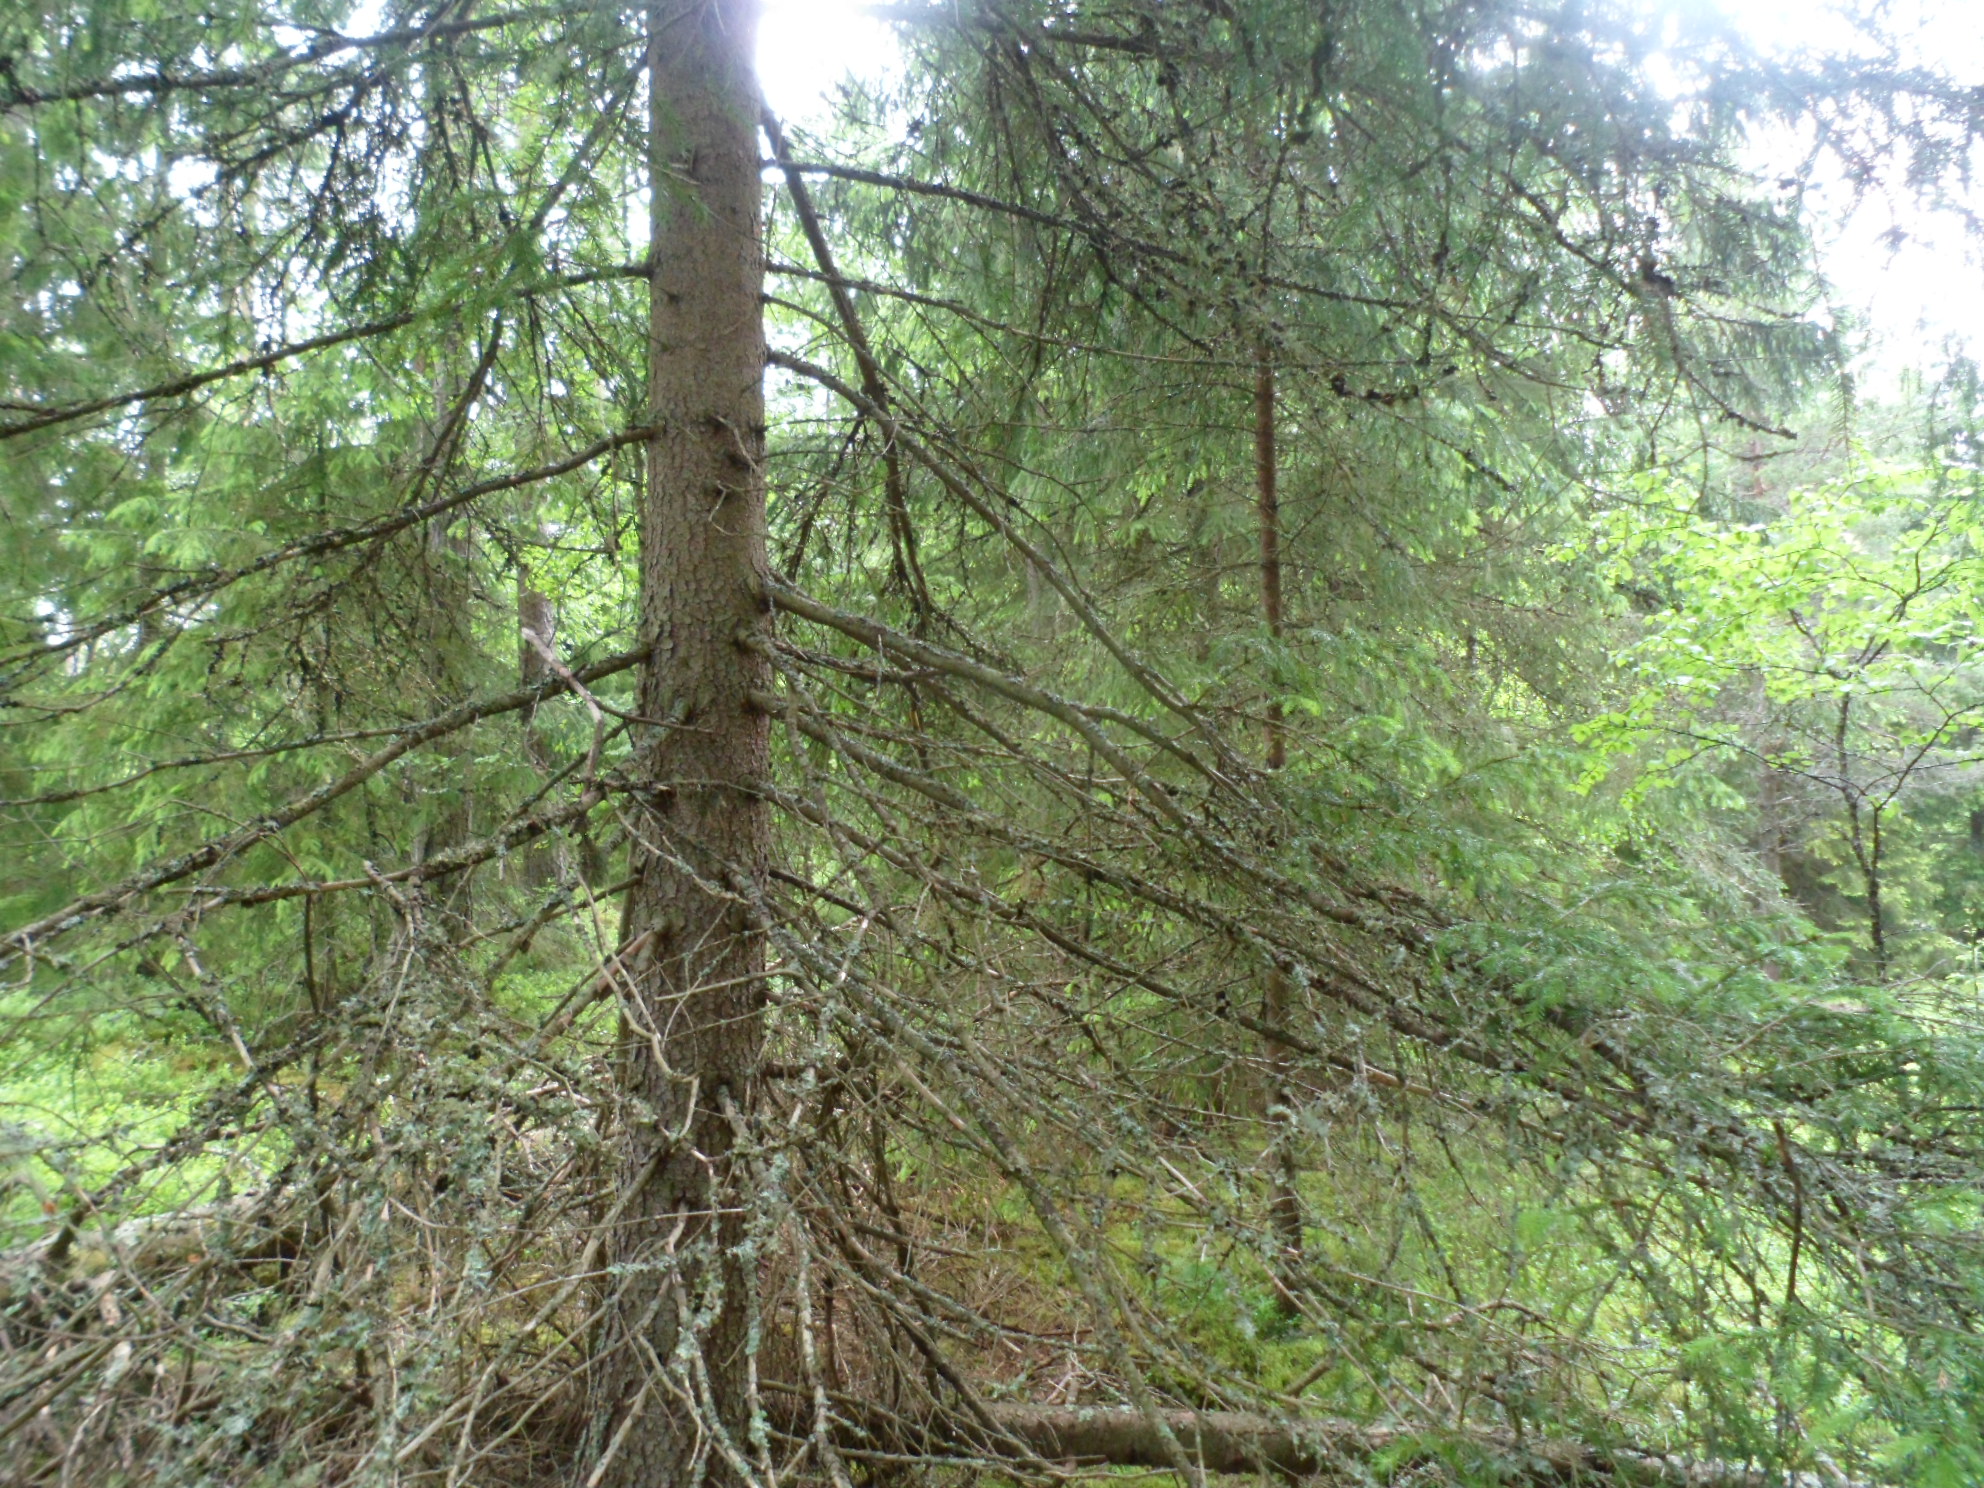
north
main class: Woodland
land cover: Spruce dominated coniferous woodland
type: boreal forest
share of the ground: 50 - 75 %
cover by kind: coniferous forest trees 55 %, shrubs 30 %, lichens and mosses 10 %, herbaceous plants 5 %
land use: Forestry
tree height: > 5 m
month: June
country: SE
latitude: 57.1455
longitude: 15.2032
